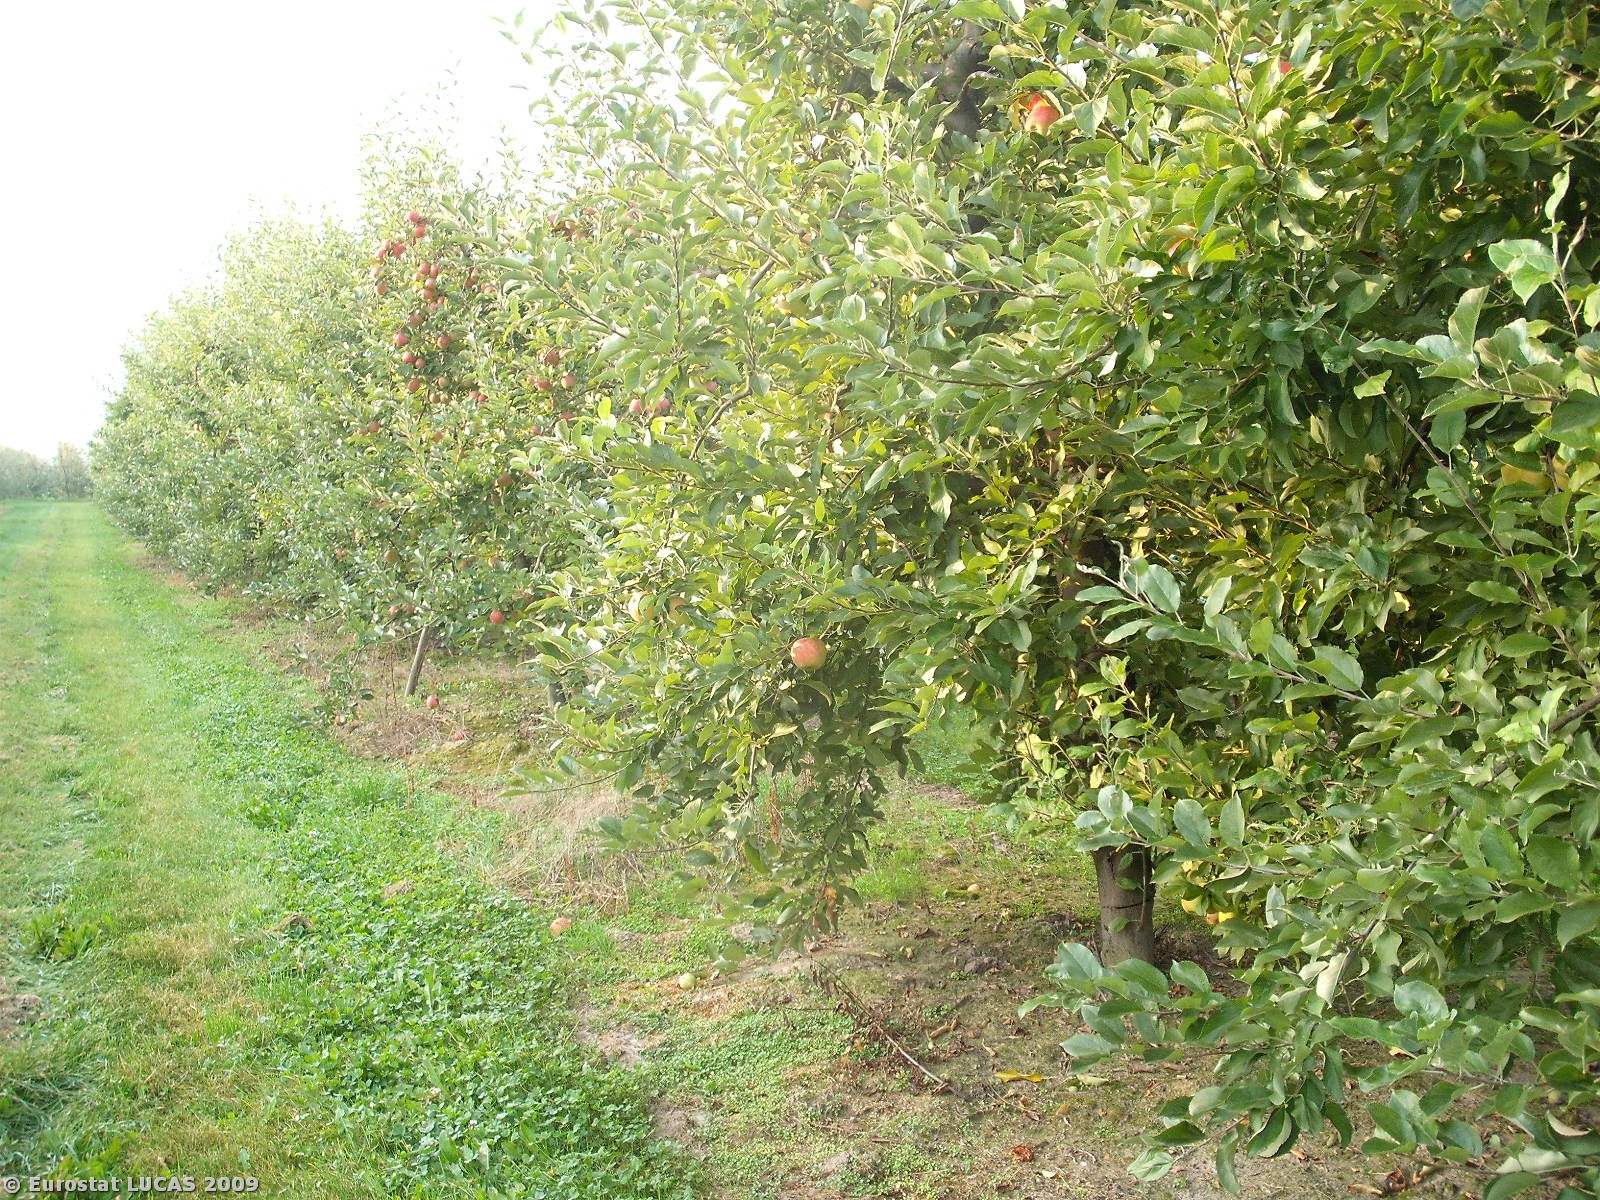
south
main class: Cropland
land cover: Apple fruit
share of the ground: 50 - 75 %
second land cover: Grassland with sparse tree/shrub cover
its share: > 75 %
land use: Agriculture (excluding fallow land and kitchen gardens)
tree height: < 5 m
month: September
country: PL
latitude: 51.7688
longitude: 20.6623
